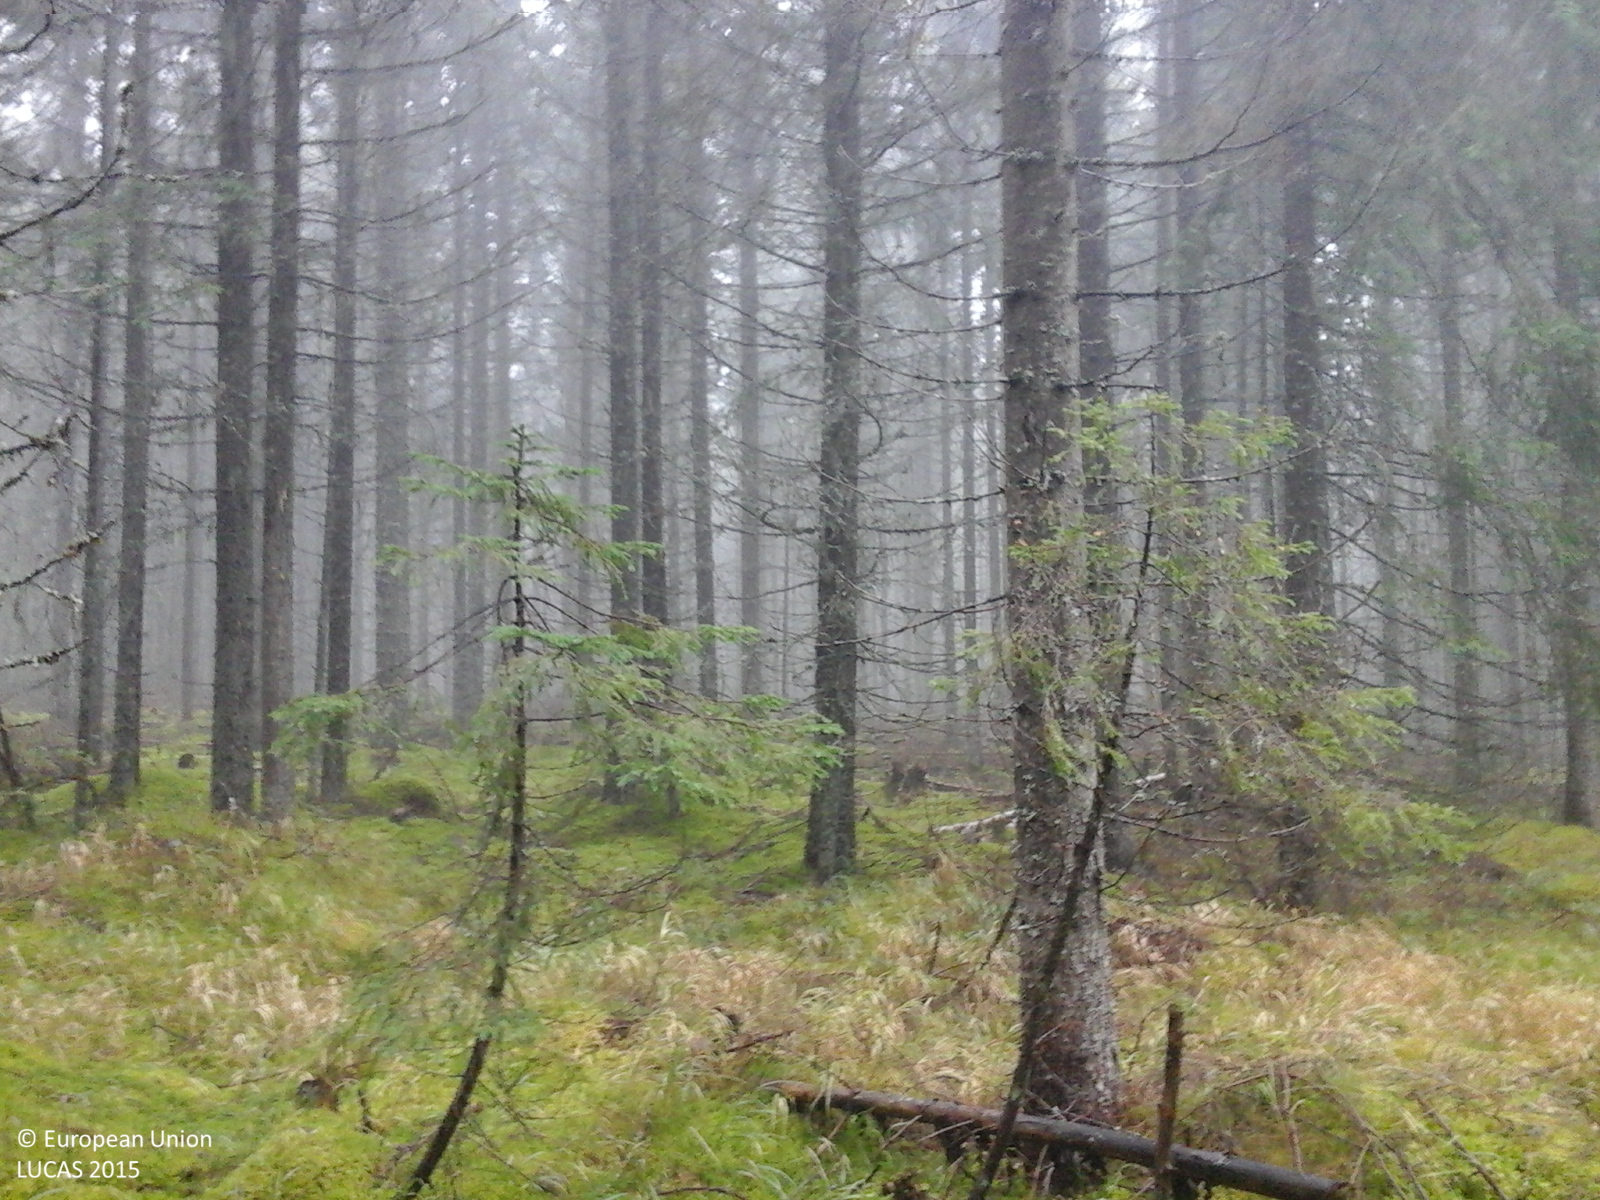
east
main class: Woodland
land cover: Spruce dominated coniferous woodland
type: alpine coniferous forest
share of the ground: > 75 %
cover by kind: coniferous forest trees 90 %, herbaceous plants 10 %
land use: Forestry
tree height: > 5 m
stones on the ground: > 50 %
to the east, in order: Spruce dominated coniferous woodland; Rivers and streams; Spruce dominated coniferous woodland
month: September
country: RO
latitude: 45.6433
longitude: 23.7303
